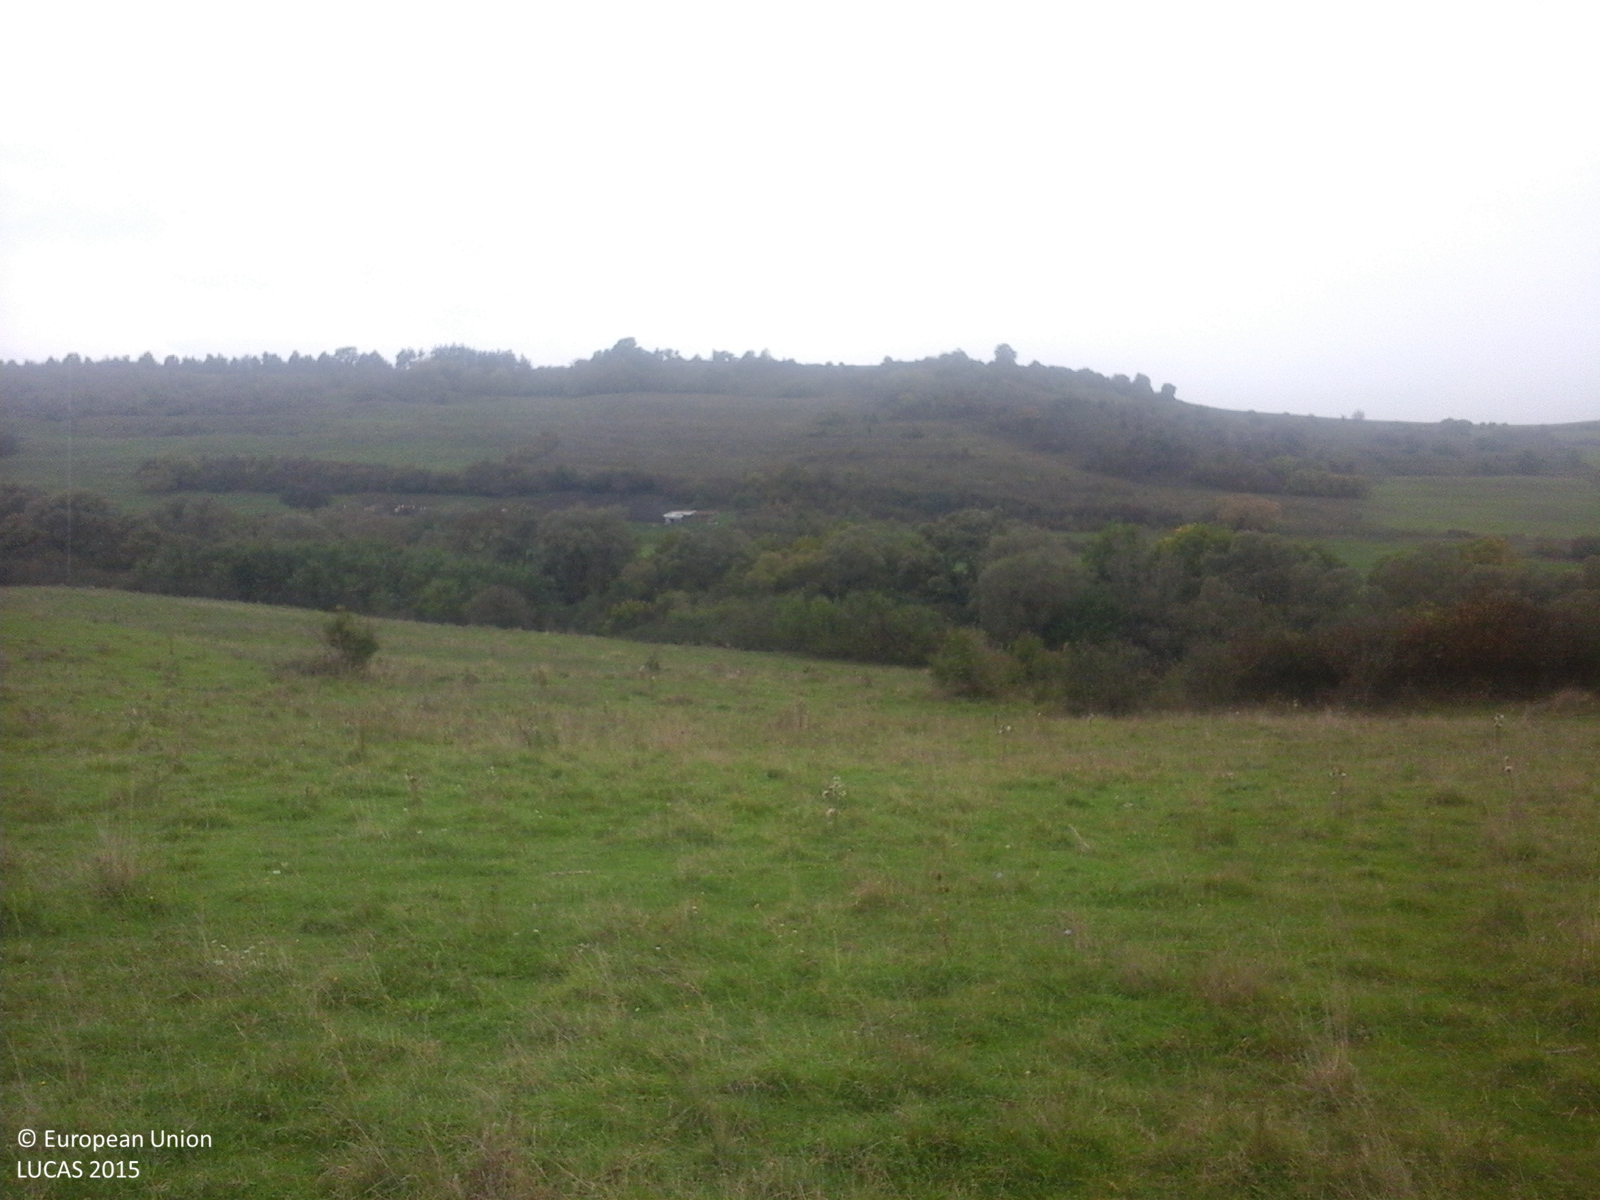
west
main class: Grassland
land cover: Grassland without tree/shrub cover
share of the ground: > 75 %
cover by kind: herbaceous plants 100 %
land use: Agriculture (excluding fallow land and kitchen gardens)
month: October
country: RO
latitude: 46.2317
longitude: 24.9145
